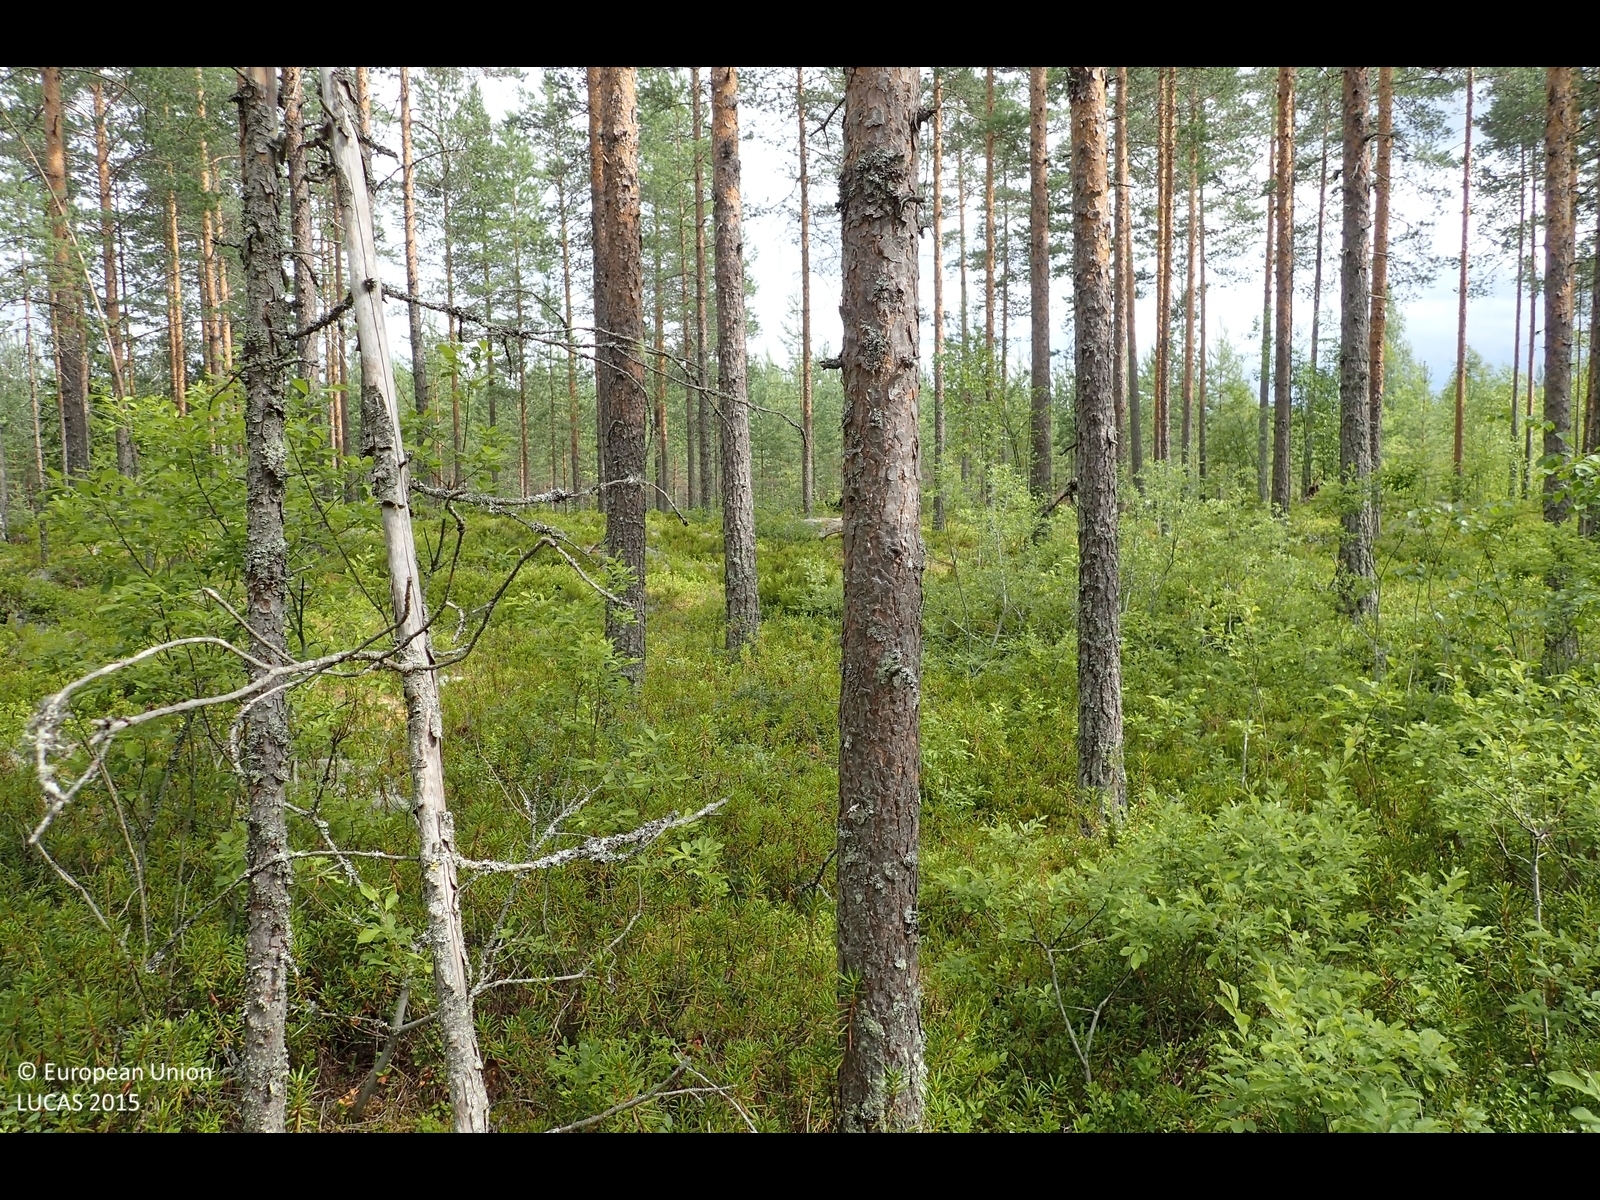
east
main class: Woodland
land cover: Pine dominated coniferous woodland
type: boreal forest
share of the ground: 50 - 75 %
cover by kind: coniferous forest trees 45 %, shrubs 45 %, broadleaved forest trees 5 %, lichens and mosses 5 %
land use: Forestry
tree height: > 5 m
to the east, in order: Pine dominated coniferous woodland; Ditches and canals; Pine dominated coniferous woodland; Ditches and canals; Pine dominated coniferous woodland; Ditches and canals; Abandoned hedges; Paved roads, cycling and walking lanes; Abandoned hedges; Ditches and canals; Pine dominated mixed woodland
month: July
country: FI
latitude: 62.6067
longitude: 23.4933
